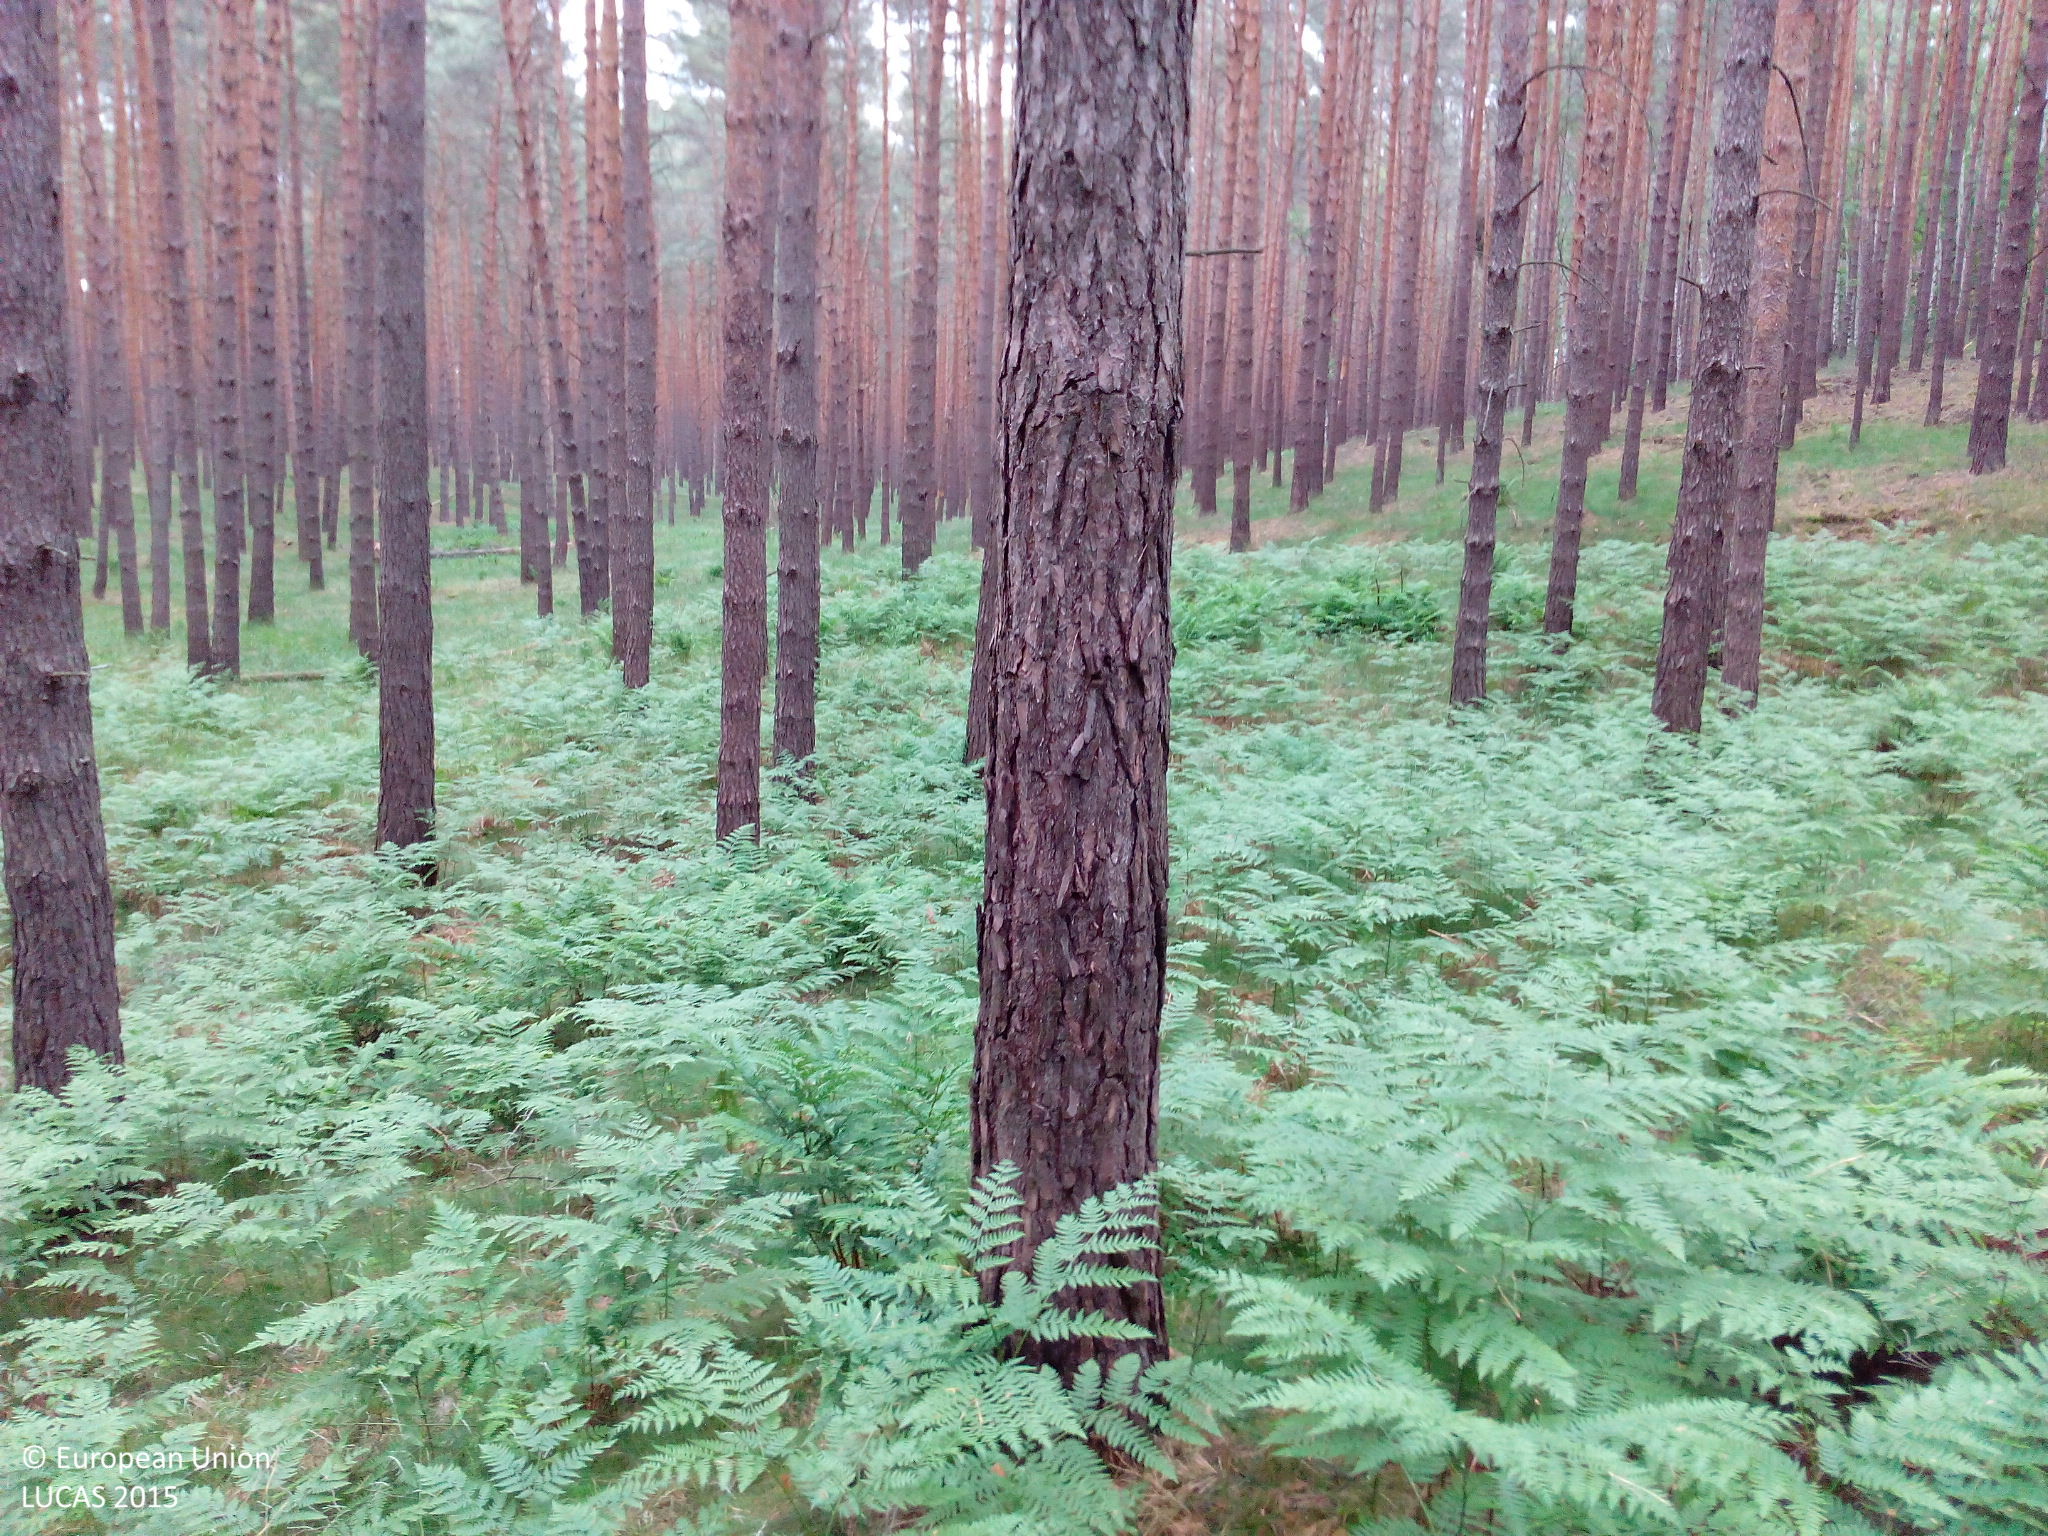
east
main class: Woodland
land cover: Pine dominated coniferous woodland
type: hemiboreal forest and nemoral coniferous forest and mixed broadleaved-coniferous forest
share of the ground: > 75 %
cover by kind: coniferous forest trees 85 %, shrubs 5 %, herbaceous plants 5 %, lichens and mosses 5 %
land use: Forestry
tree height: > 5 m
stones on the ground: < 10 %
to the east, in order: Pine dominated coniferous woodland; Tracks; Pine dominated coniferous woodland
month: June
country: DE
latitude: 52.1874
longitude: 12.5887
